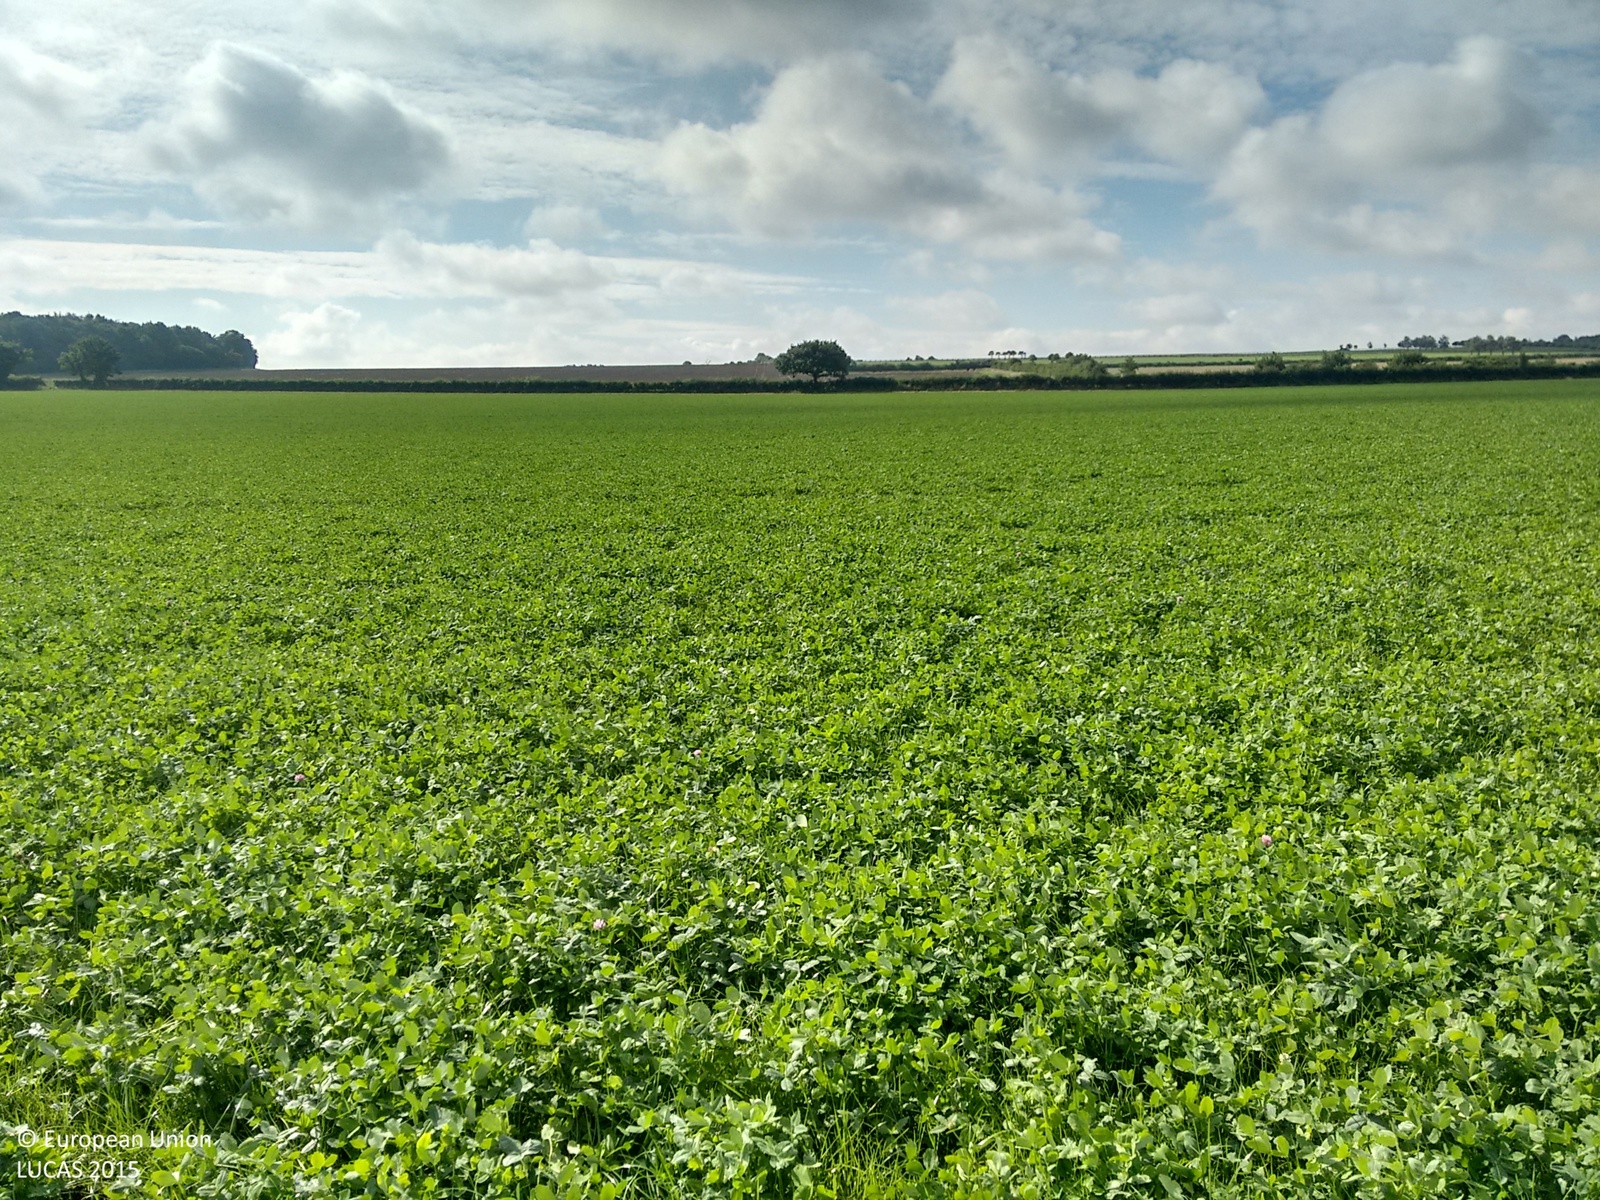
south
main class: Cropland
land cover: Clovers
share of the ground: > 75 %
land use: Agriculture (excluding fallow land and kitchen gardens)
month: September
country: GB
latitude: 52.2132
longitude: 0.5031
